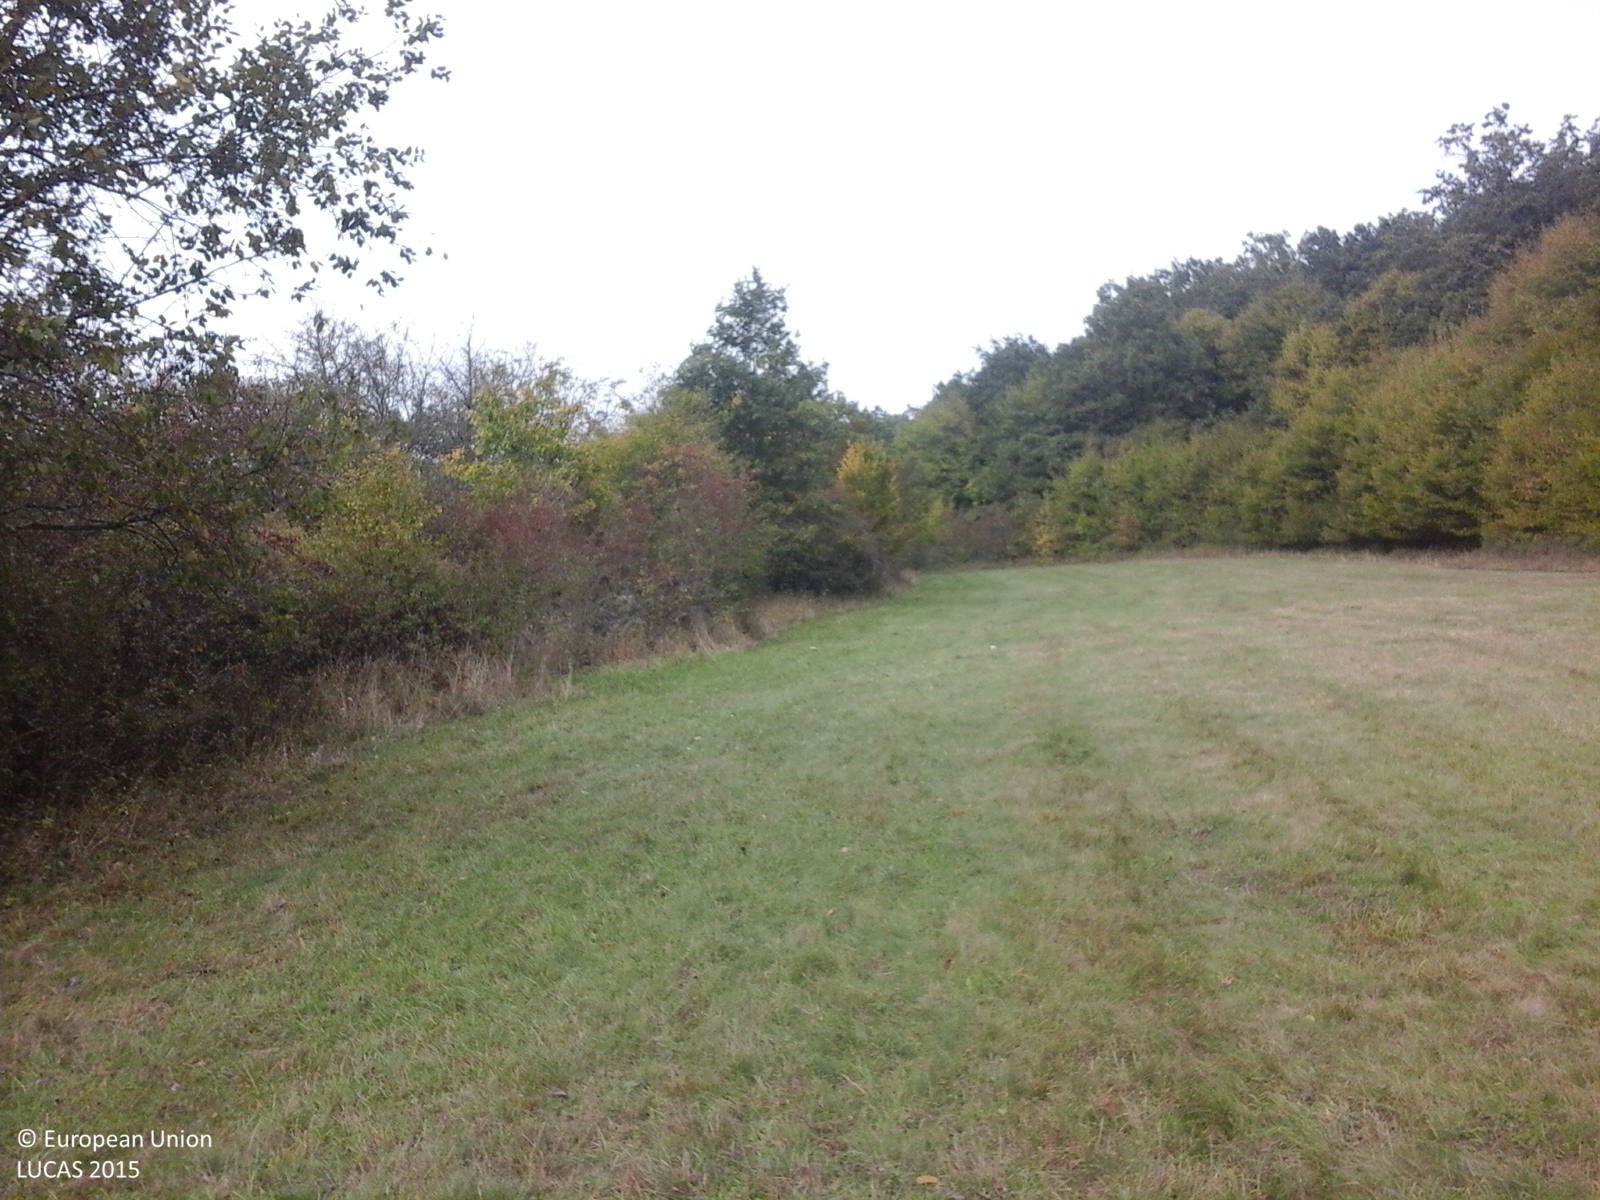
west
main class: Grassland
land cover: Grassland without tree/shrub cover
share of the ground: > 75 %
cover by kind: herbaceous plants 100 %
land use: Agriculture (excluding fallow land and kitchen gardens)
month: October
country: RO
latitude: 45.8657
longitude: 24.6541
